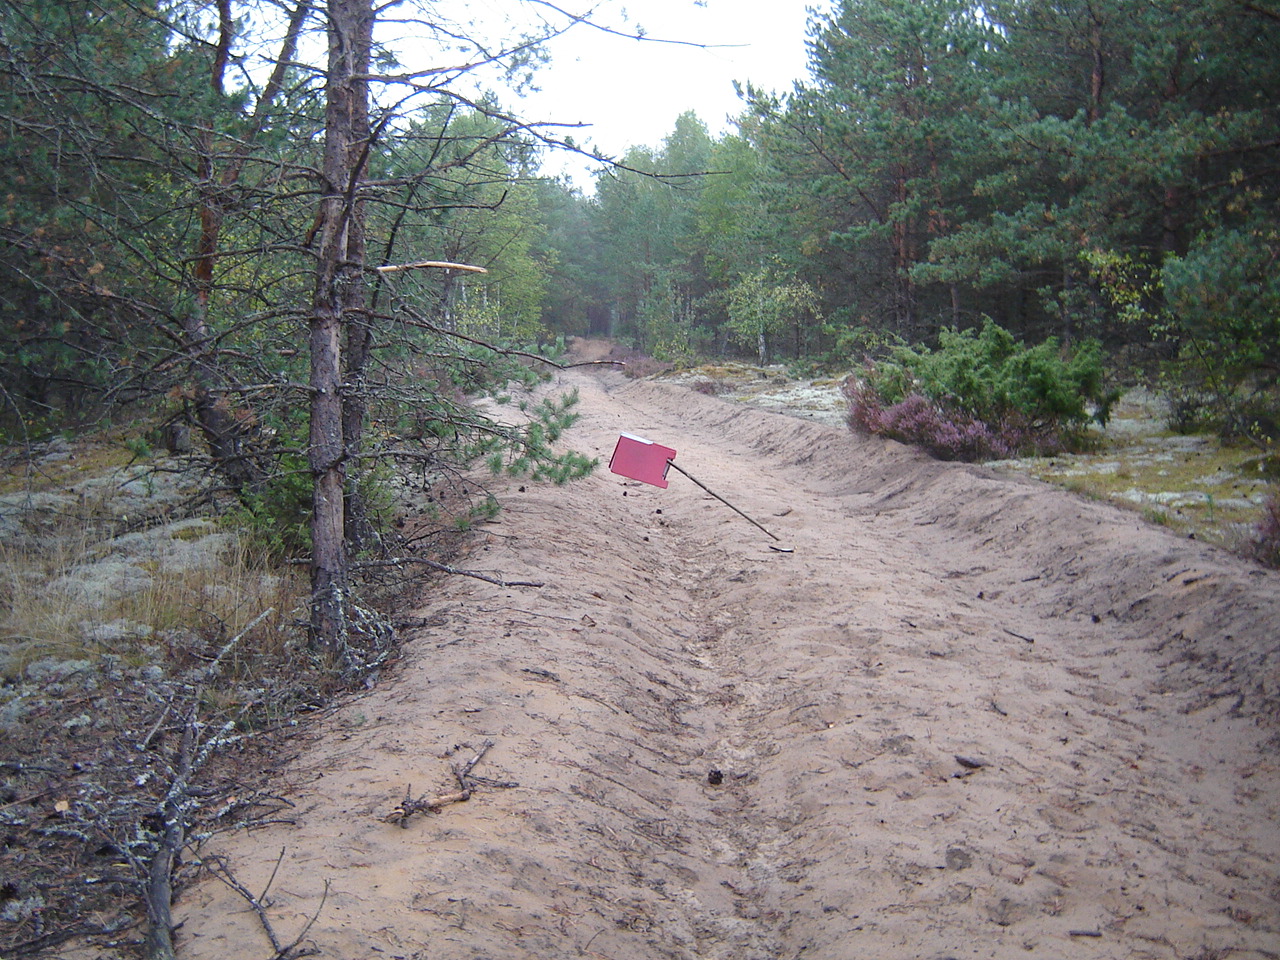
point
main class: Woodland
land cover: Pine dominated coniferous woodland
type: hemiboreal forest and nemoral coniferous forest and mixed broadleaved-coniferous forest
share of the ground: > 75 %
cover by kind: coniferous forest trees 85 %, lichens and mosses 15 %
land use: Forestry
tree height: > 5 m
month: September
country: LT
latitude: 54.3305
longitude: 24.8275
